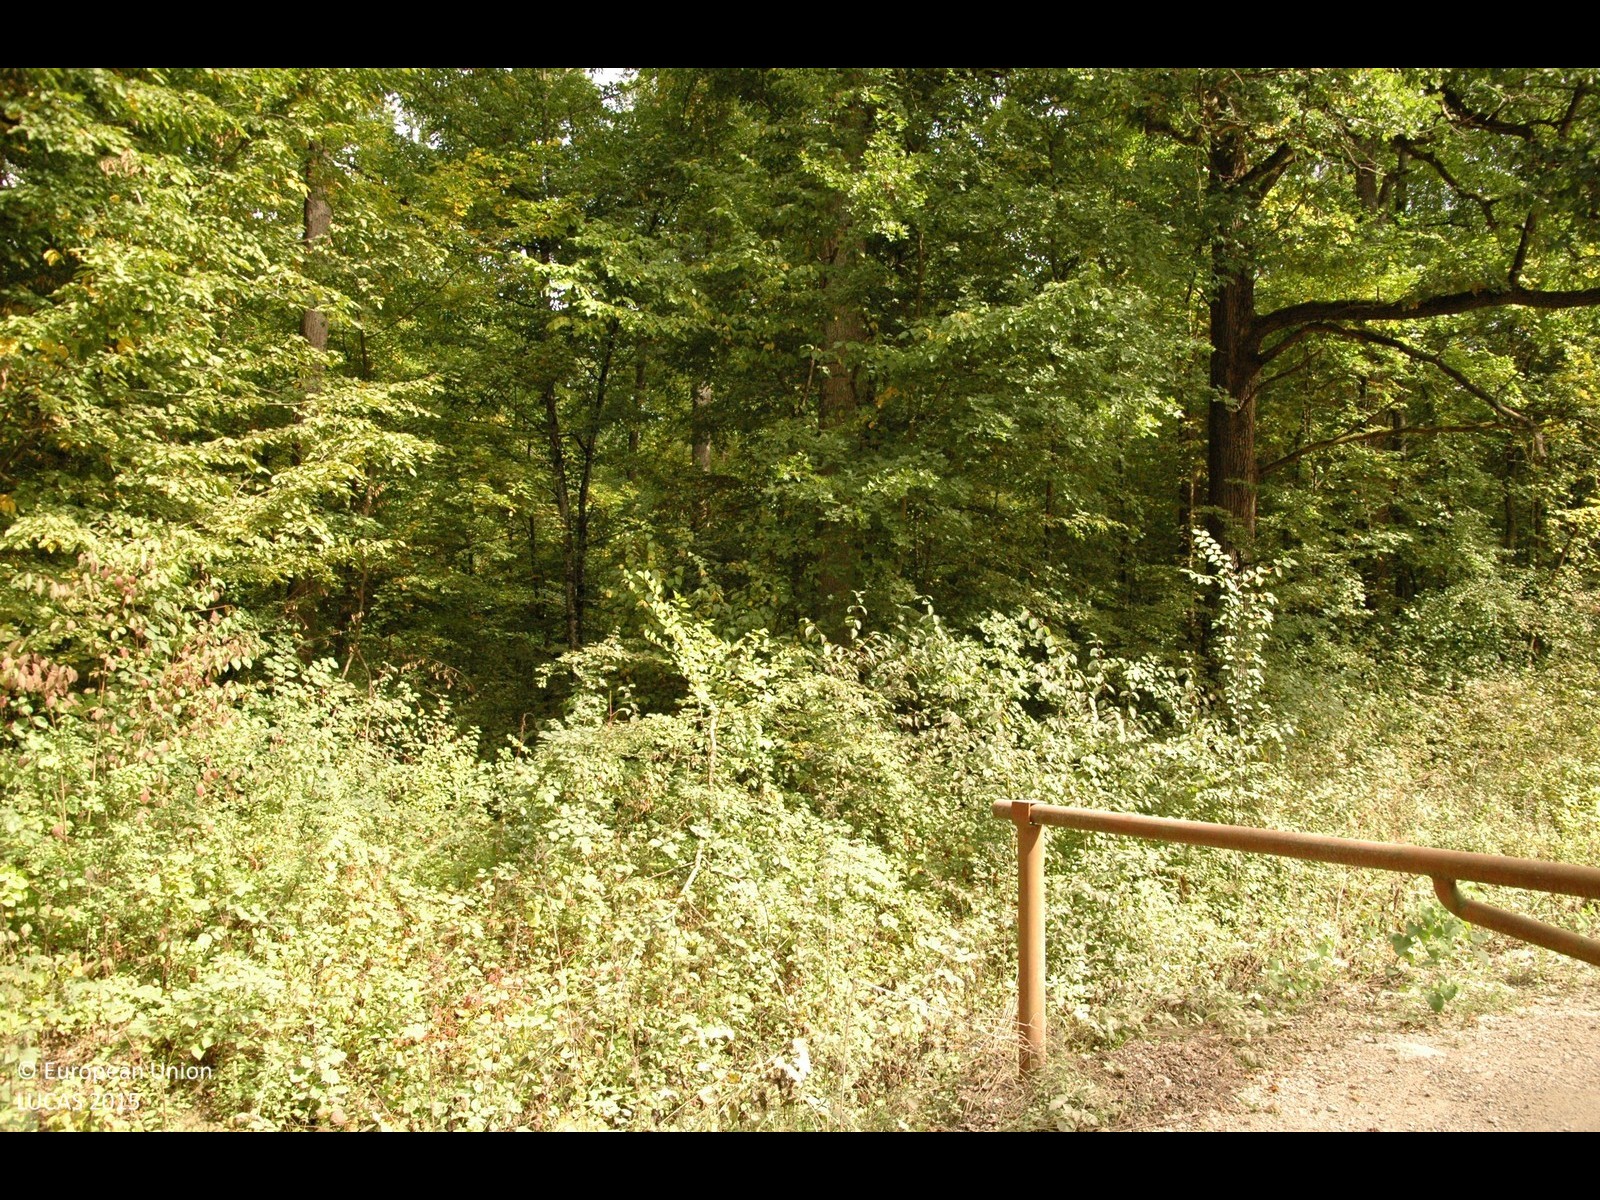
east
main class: Woodland
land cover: Broadleaved woodland
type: mesophytic deciduous forest
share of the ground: > 75 %
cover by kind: broadleaved forest trees 100 %
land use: Forestry
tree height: > 5 m
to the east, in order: Broadleaved woodland
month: September
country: HR
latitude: 45.6088
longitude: 16.2424
